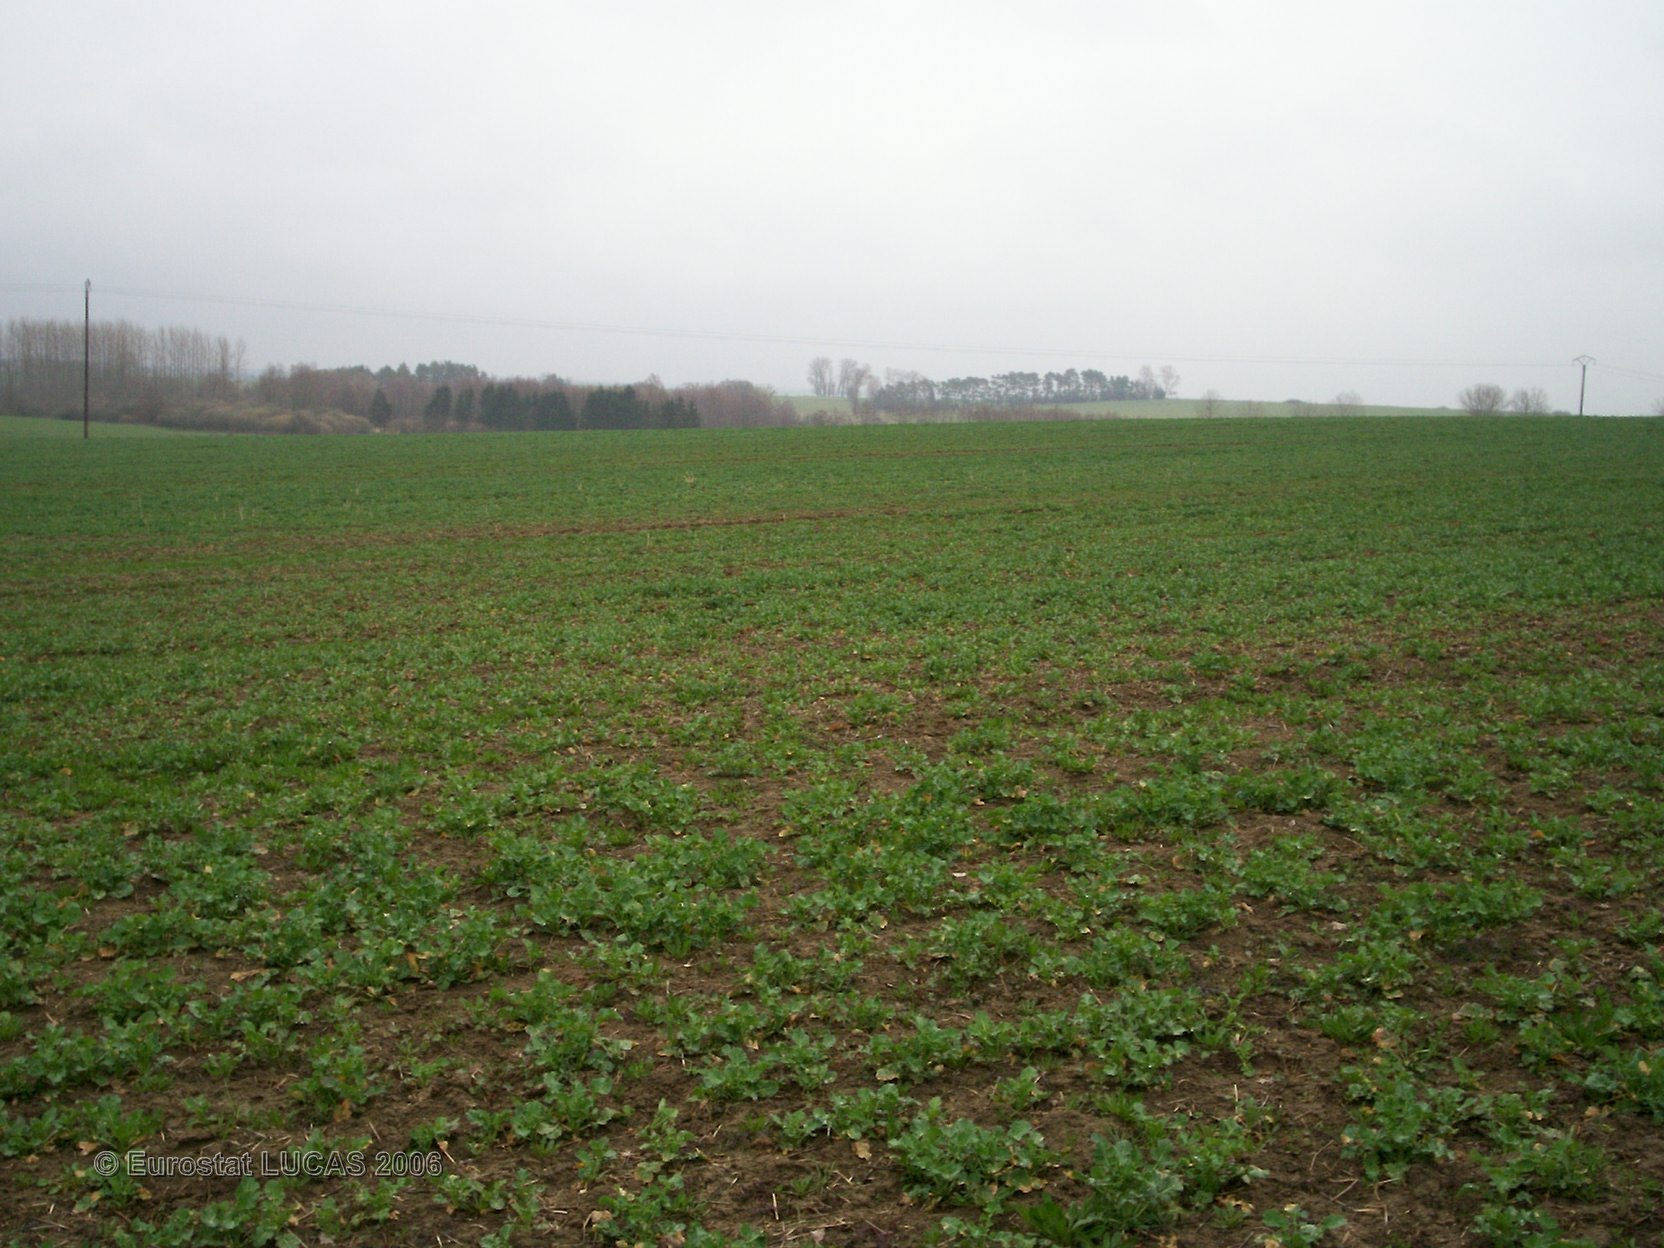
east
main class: Cropland
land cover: Rape and turnip rape
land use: Agriculture (excluding fallow land and kitchen gardens)
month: April
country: FR
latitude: 48.6628
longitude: 6.7827
